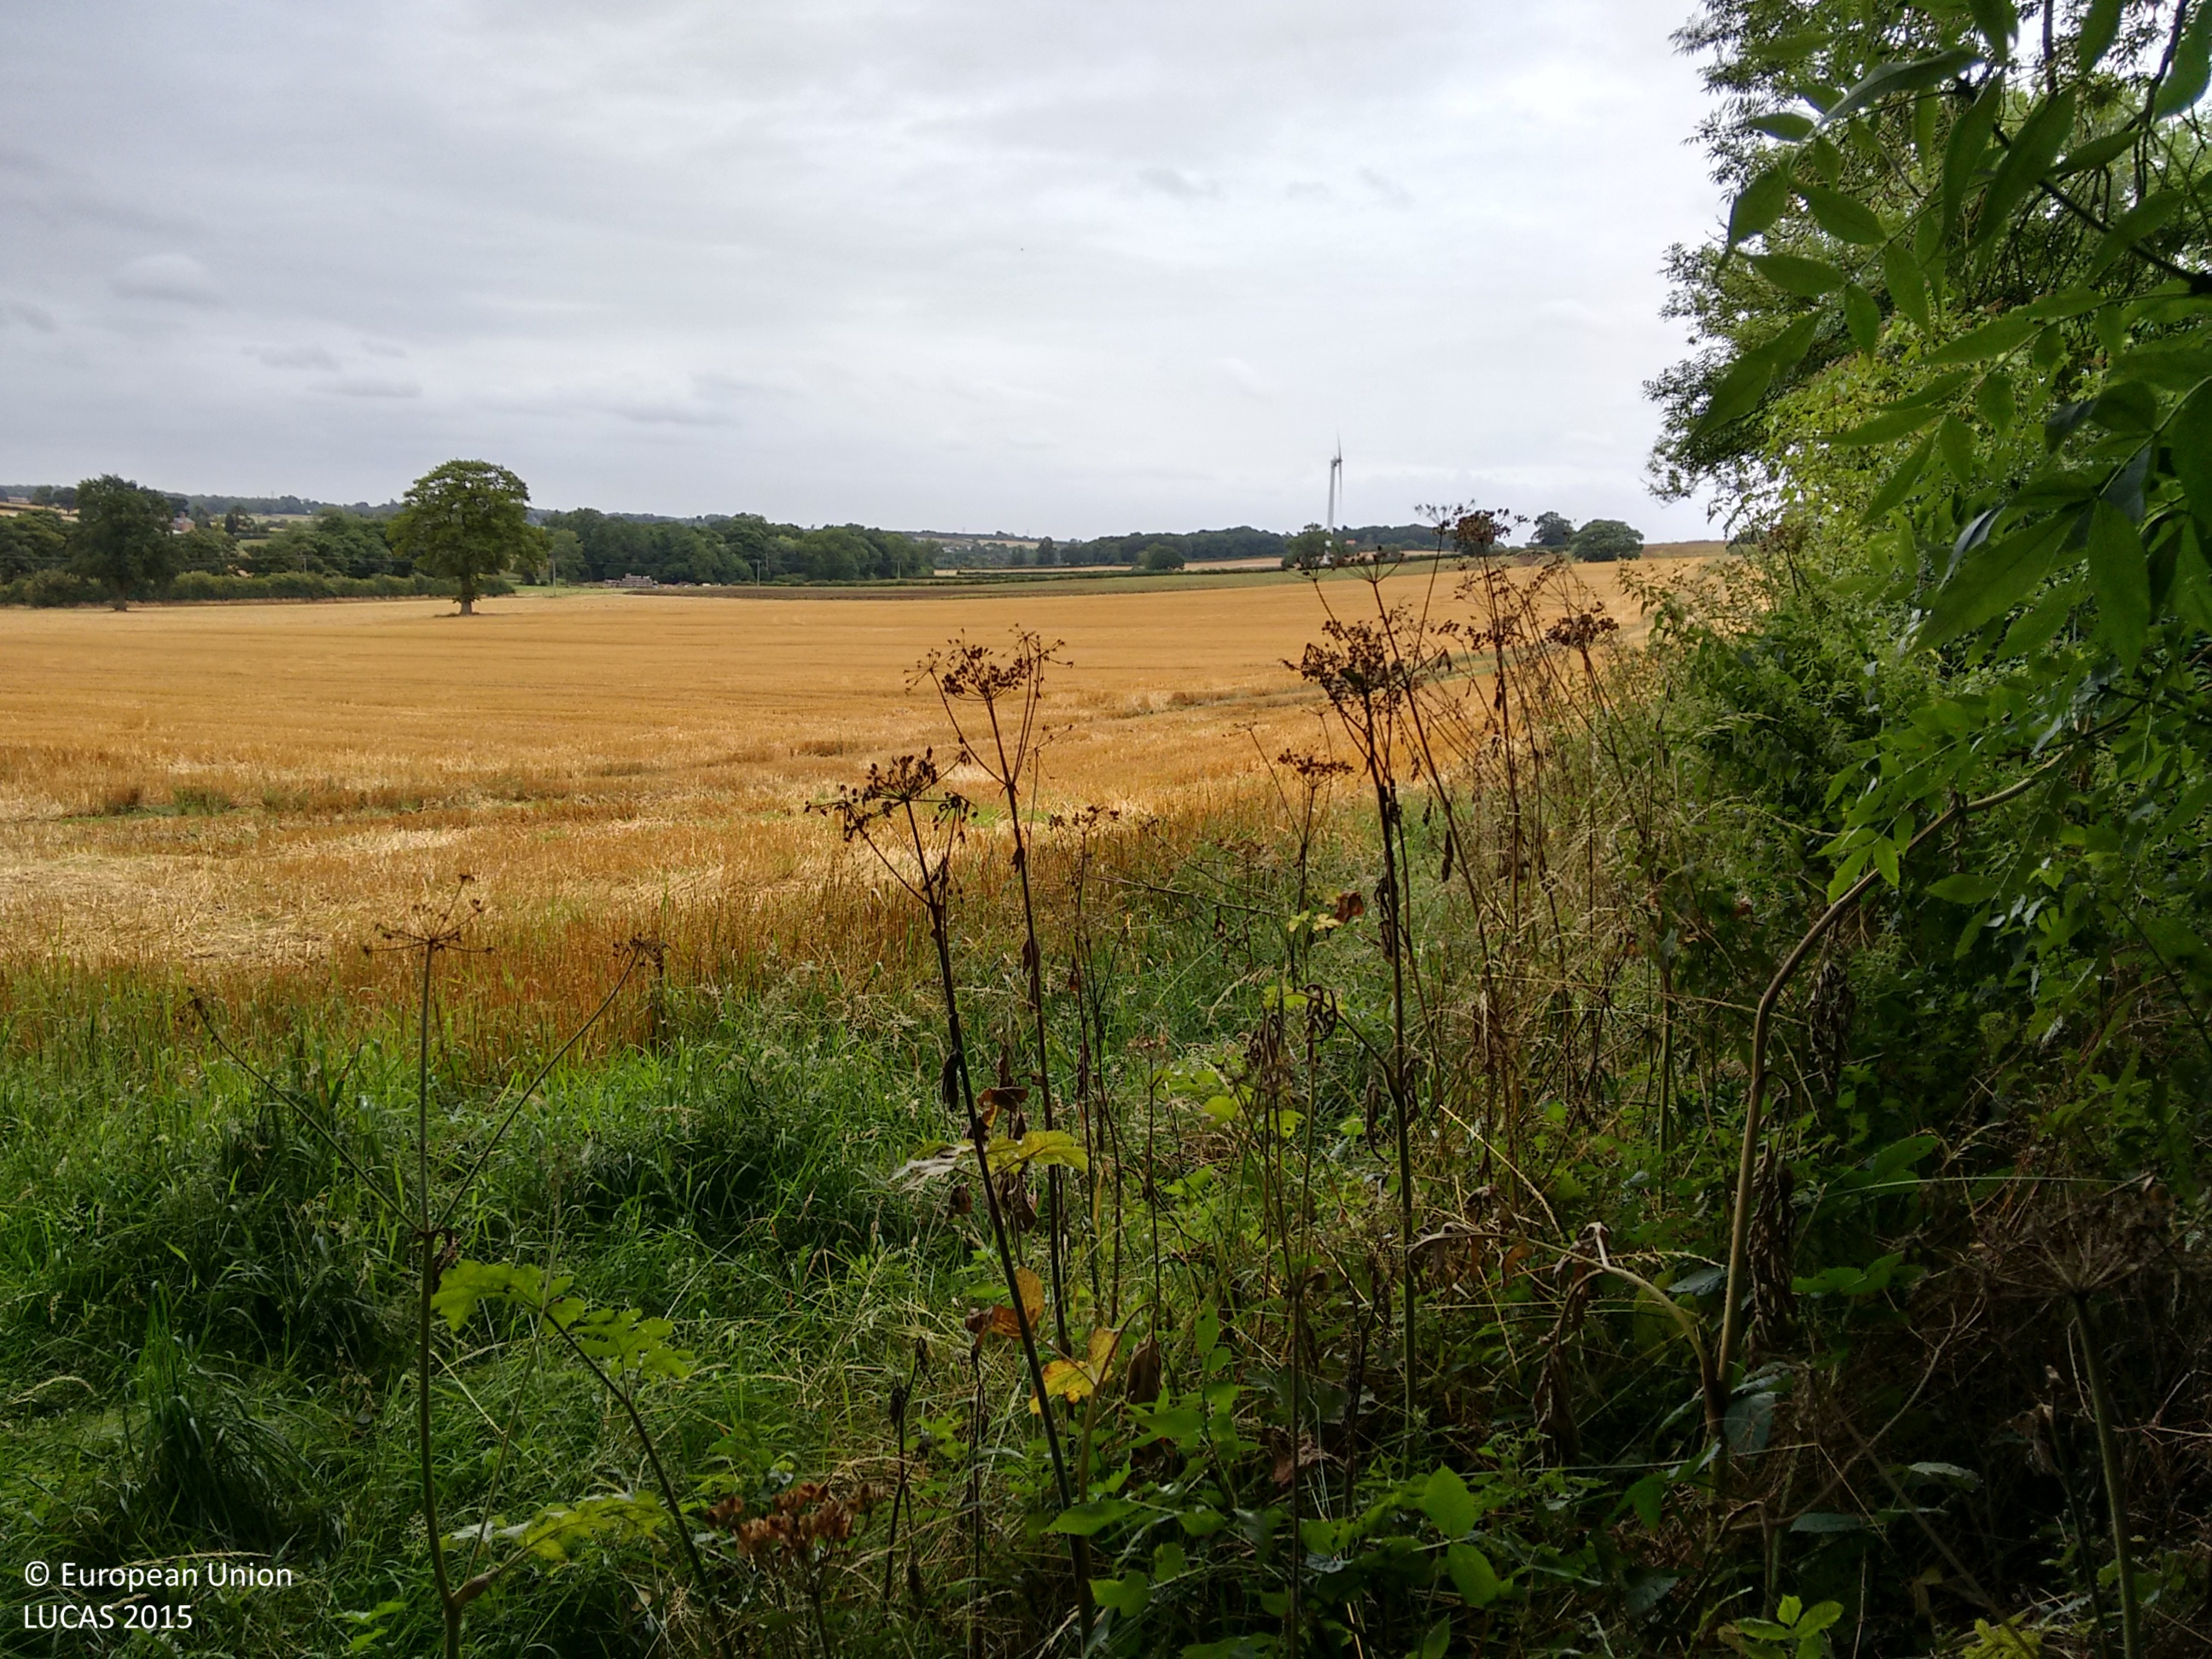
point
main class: Cropland
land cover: Common wheat
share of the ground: > 75 %
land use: Agriculture (excluding fallow land and kitchen gardens)
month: August
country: GB
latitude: 52.6329
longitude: -1.3220
